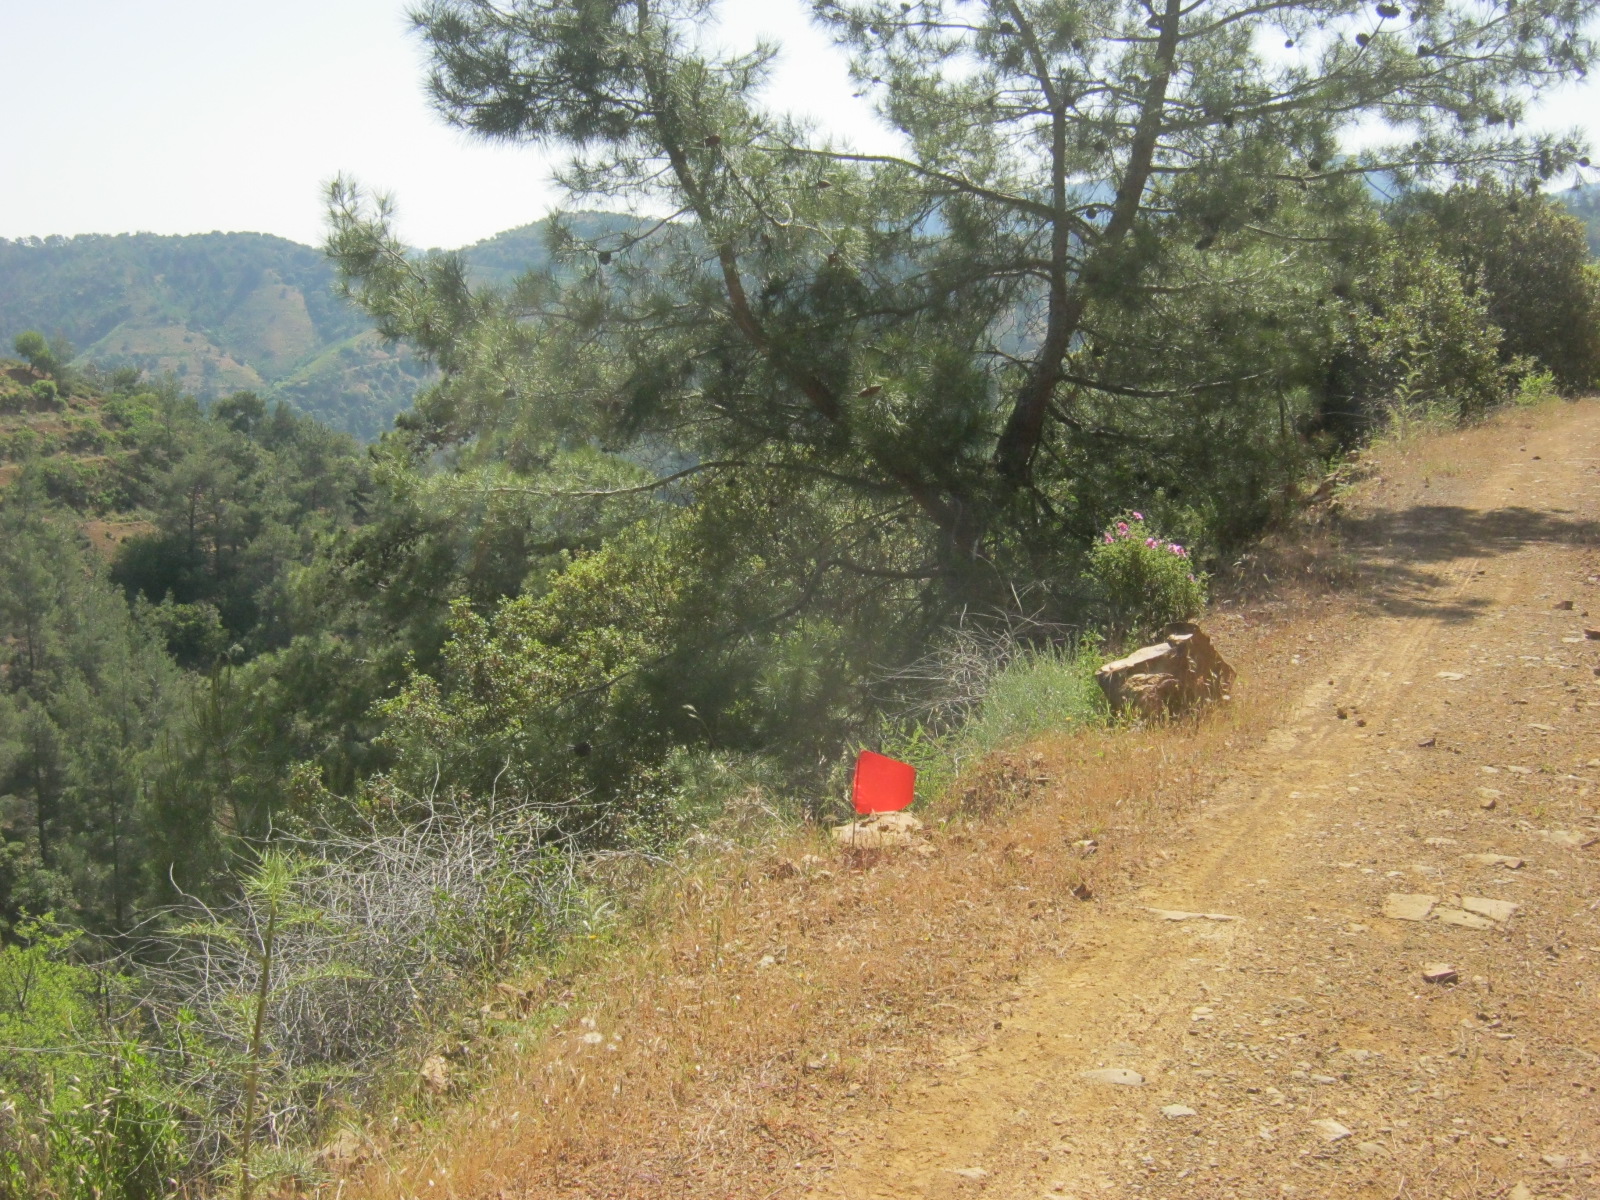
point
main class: Woodland
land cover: Pine dominated coniferous woodland
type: coniferous forest of the mediterranean region
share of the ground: 50 - 75 %
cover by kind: coniferous forest trees 60 %, shrubs 20 %, unconsolidated bare surface 20 %
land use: Forestry
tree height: > 5 m
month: May
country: CY
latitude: 35.0145
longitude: 32.7962
